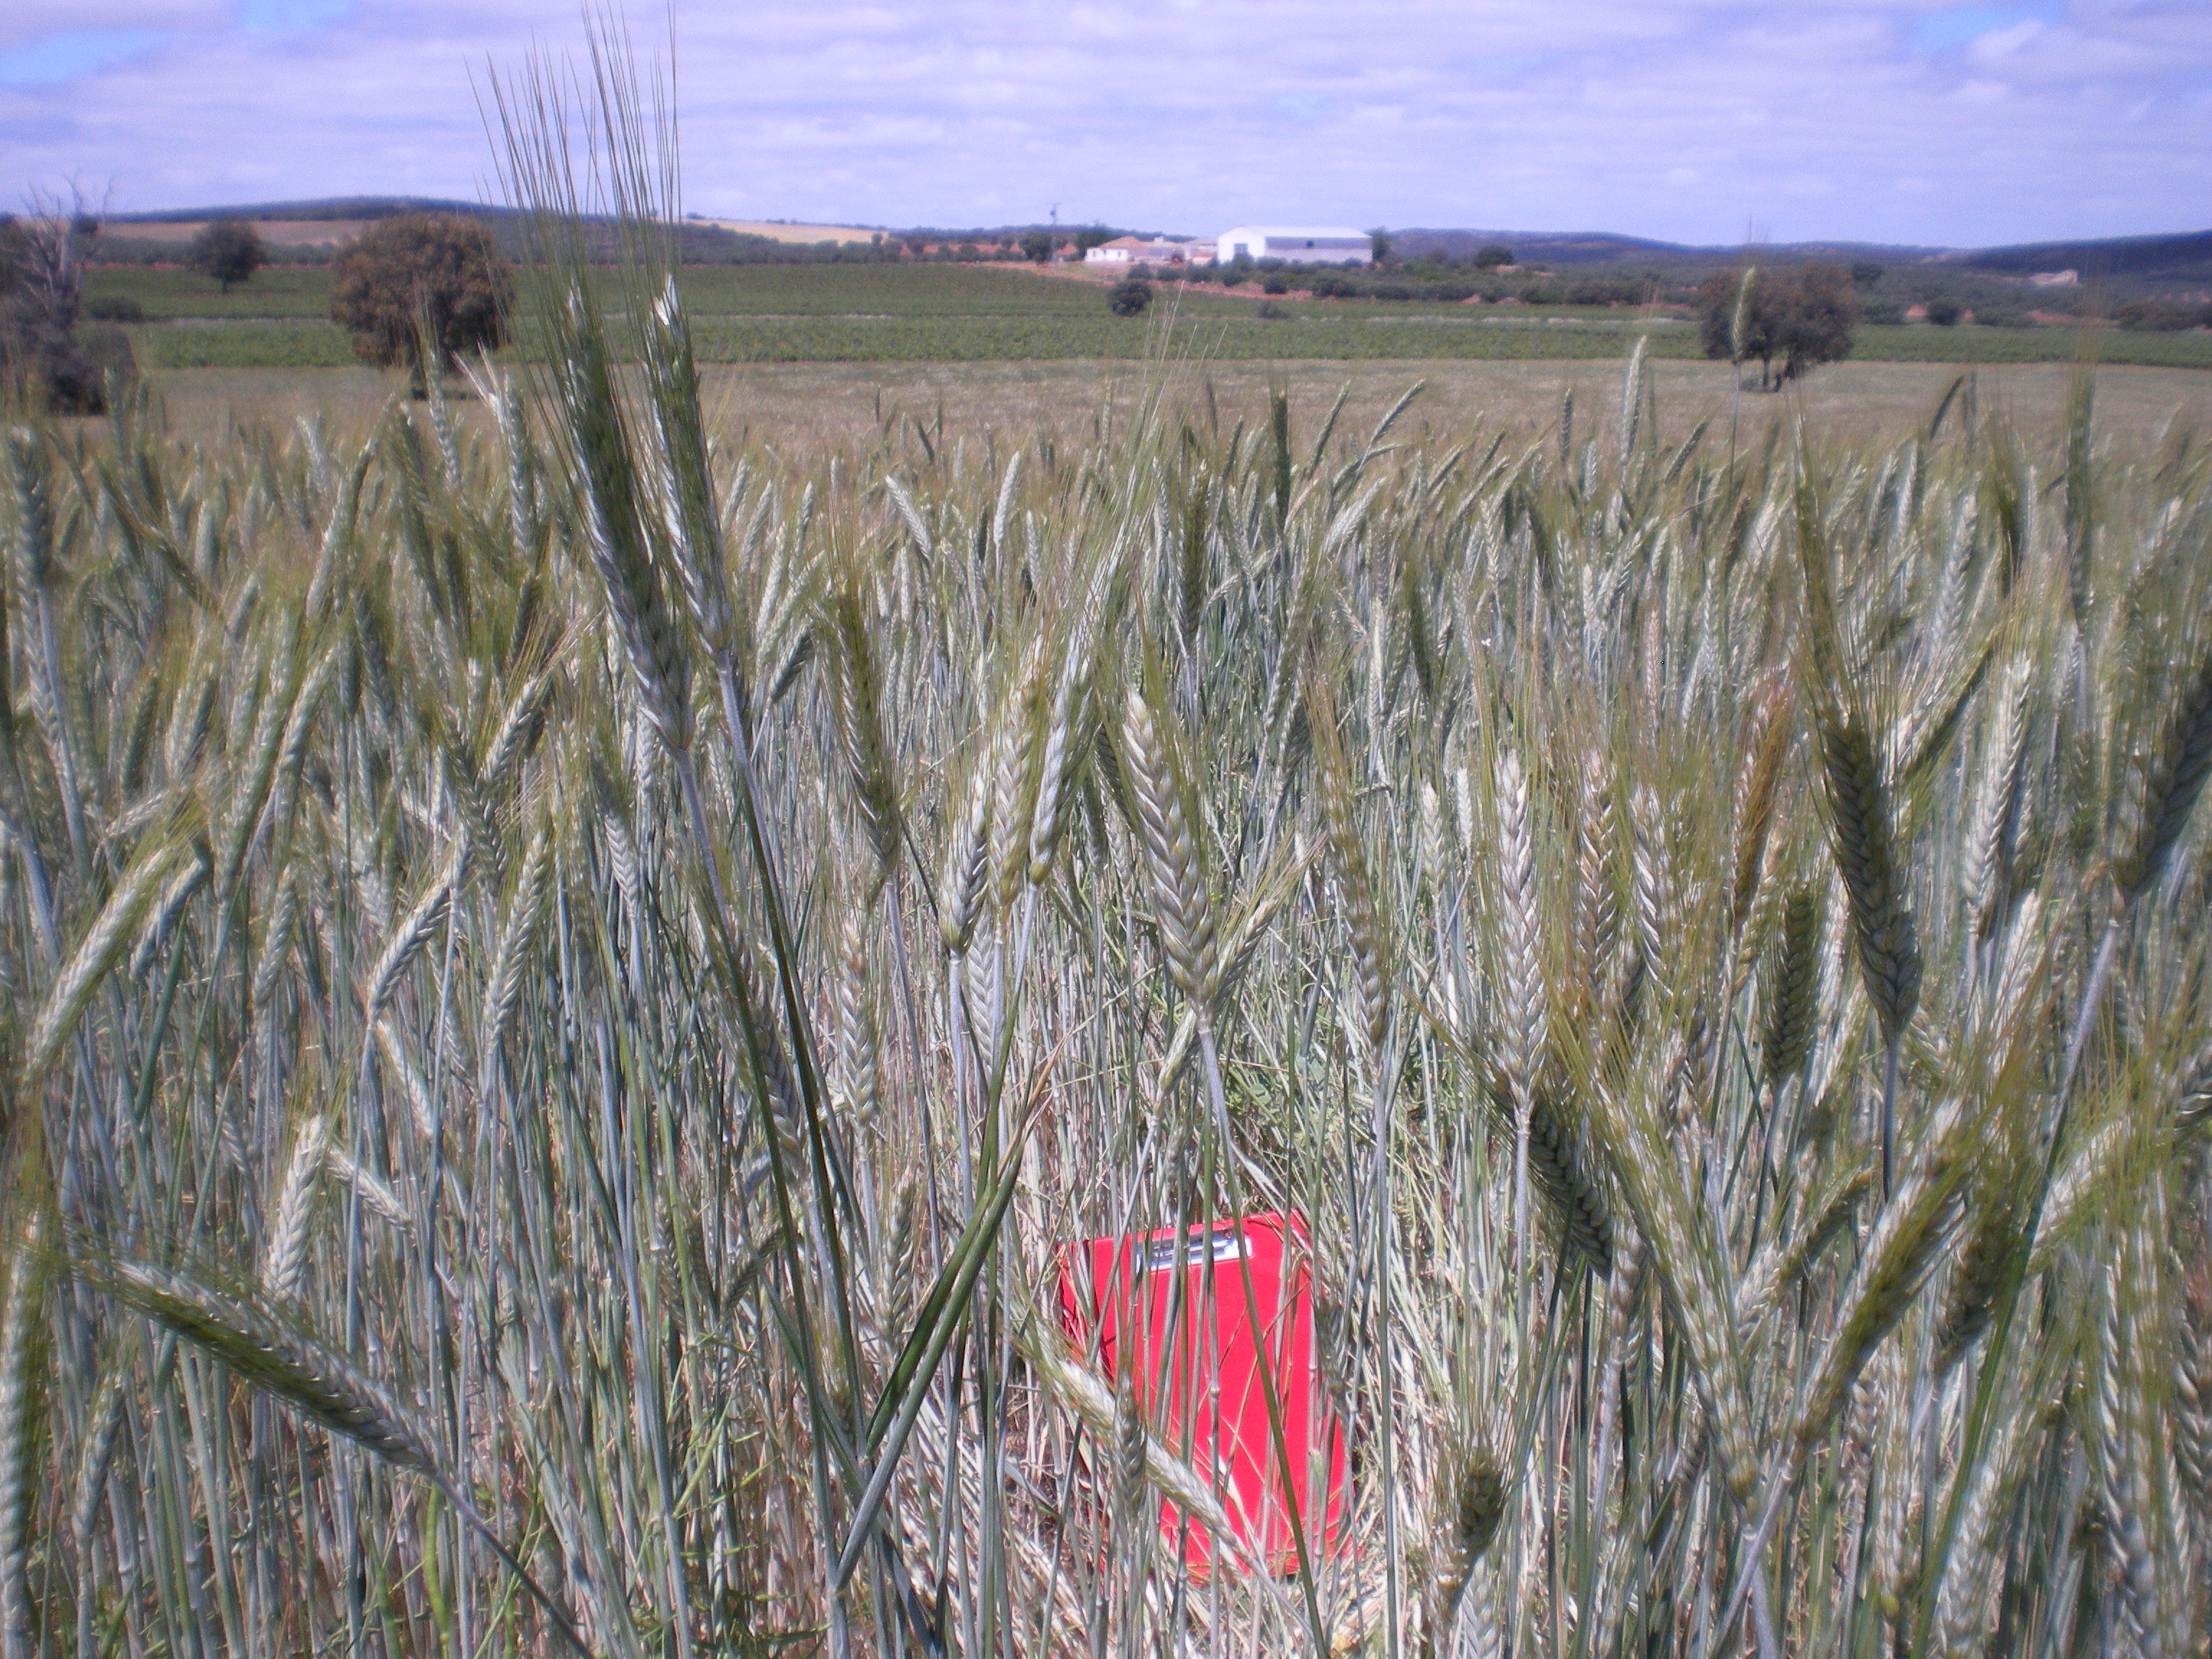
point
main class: Cropland
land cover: Durum wheat
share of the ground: > 75 %
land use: Agriculture (excluding fallow land and kitchen gardens)
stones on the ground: 10 - 25 %
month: May
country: ES
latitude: 38.8732
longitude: -3.4878
